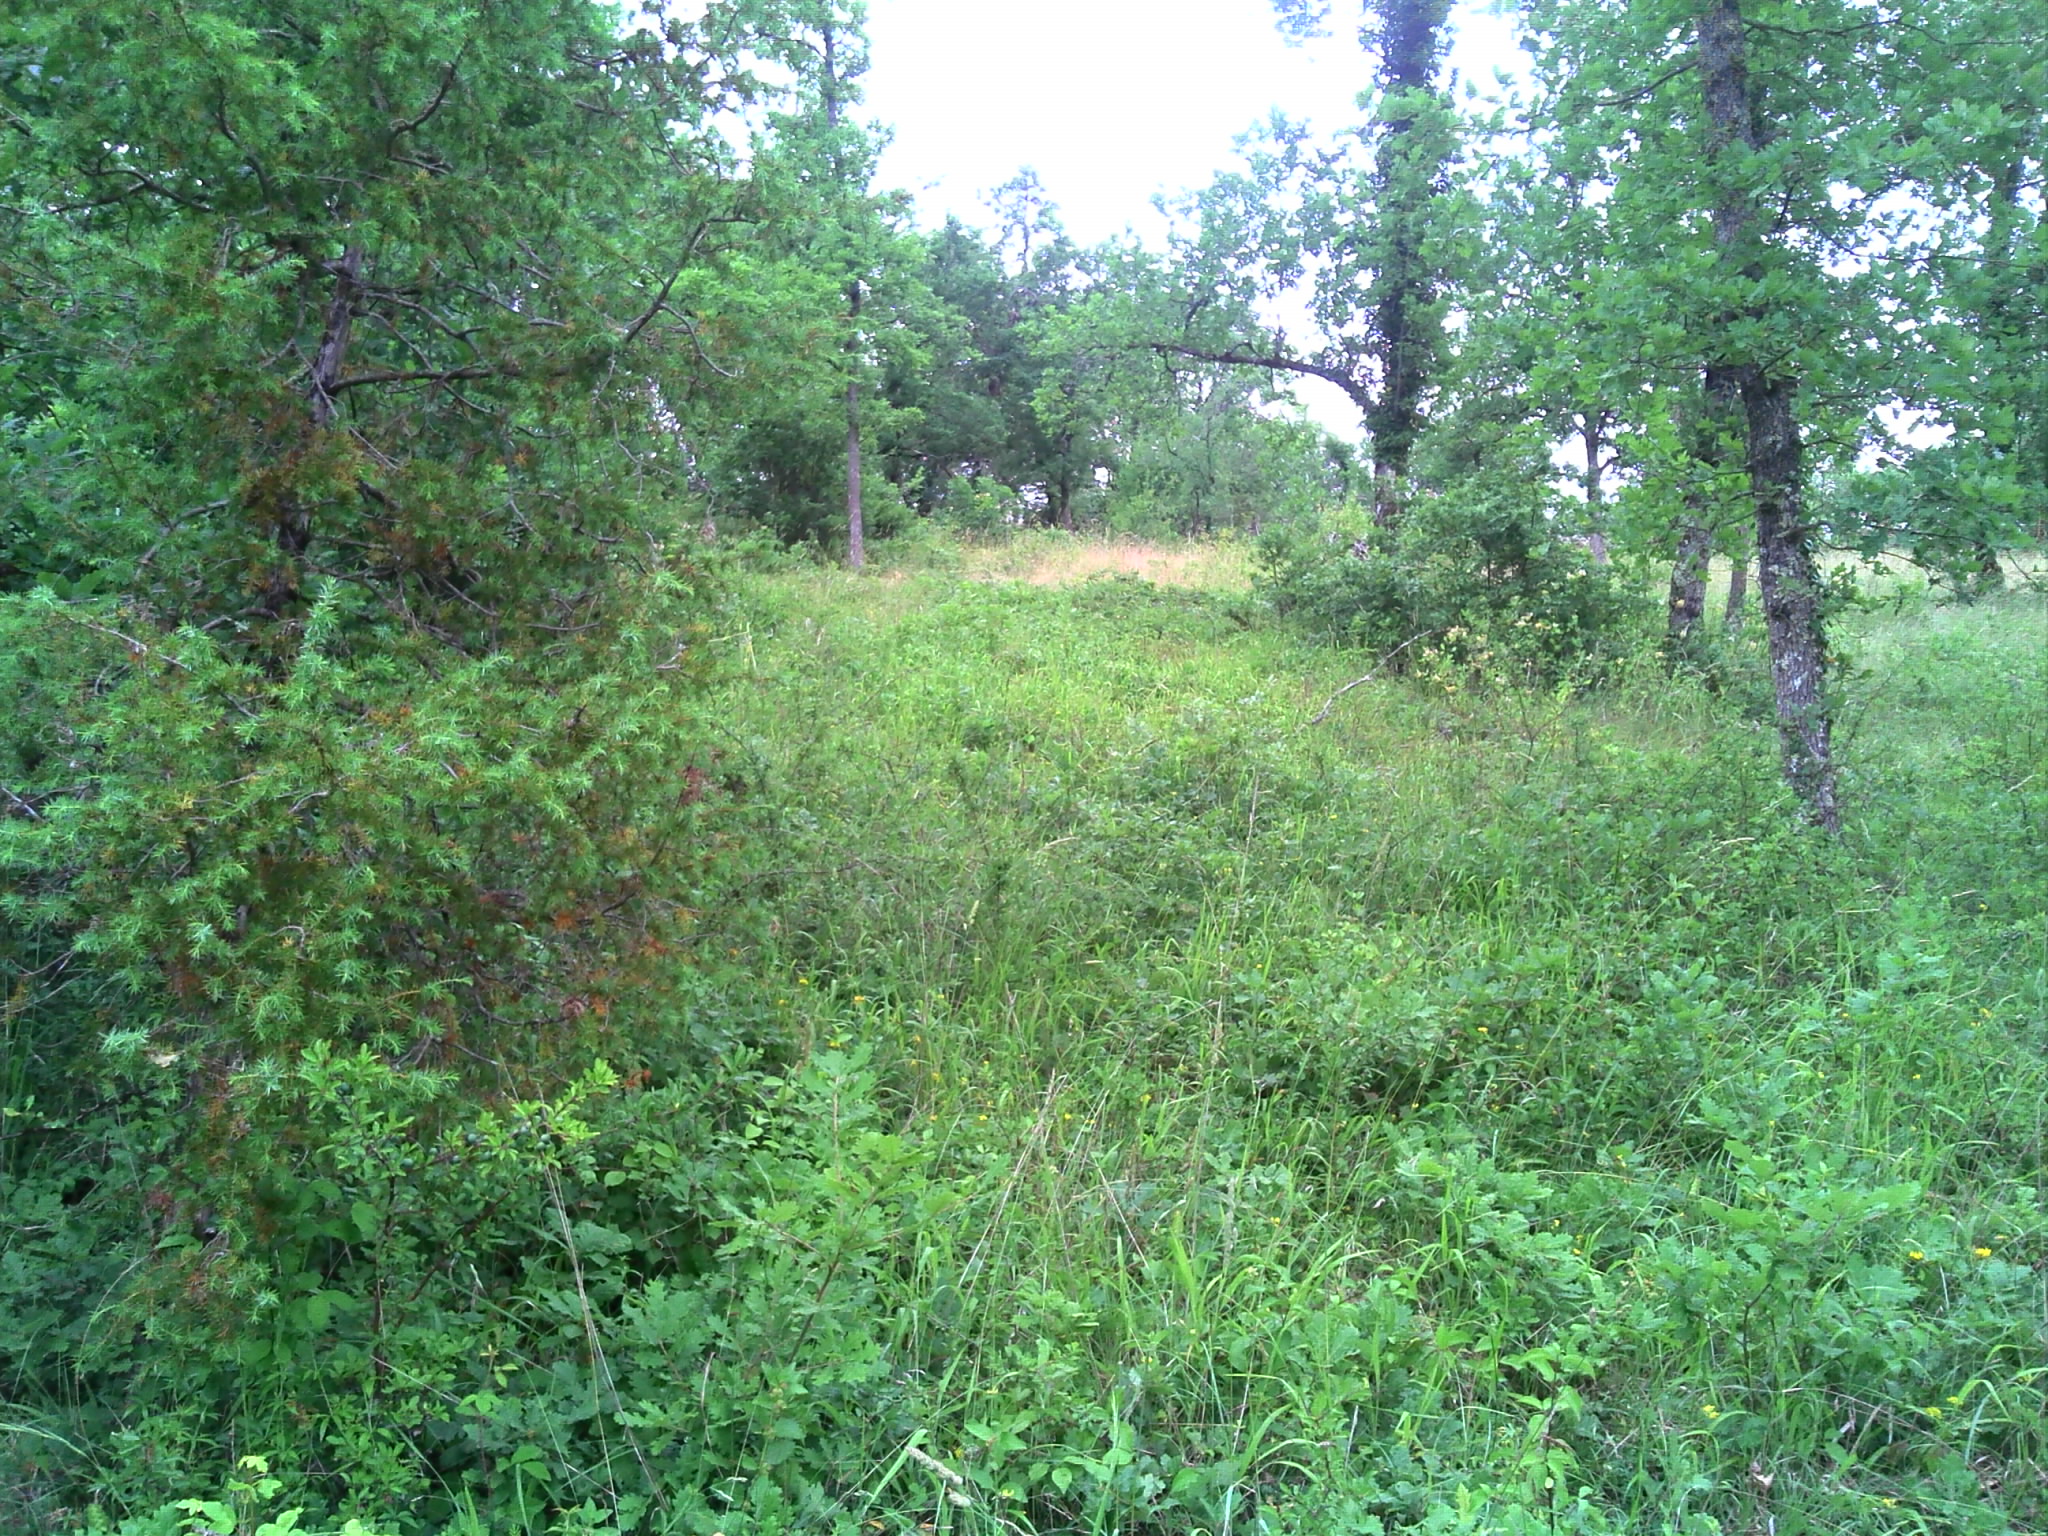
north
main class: Woodland
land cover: Broadleaved woodland
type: acidophilous oak and oak-birch forest
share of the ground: > 75 %
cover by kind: broadleaved forest trees 75 %, shrubs 20 %, herbaceous plants 5 %
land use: Forestry
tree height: > 5 m
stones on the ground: 25 - 50 %
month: June
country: FR
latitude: 44.4082
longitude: 1.8254
